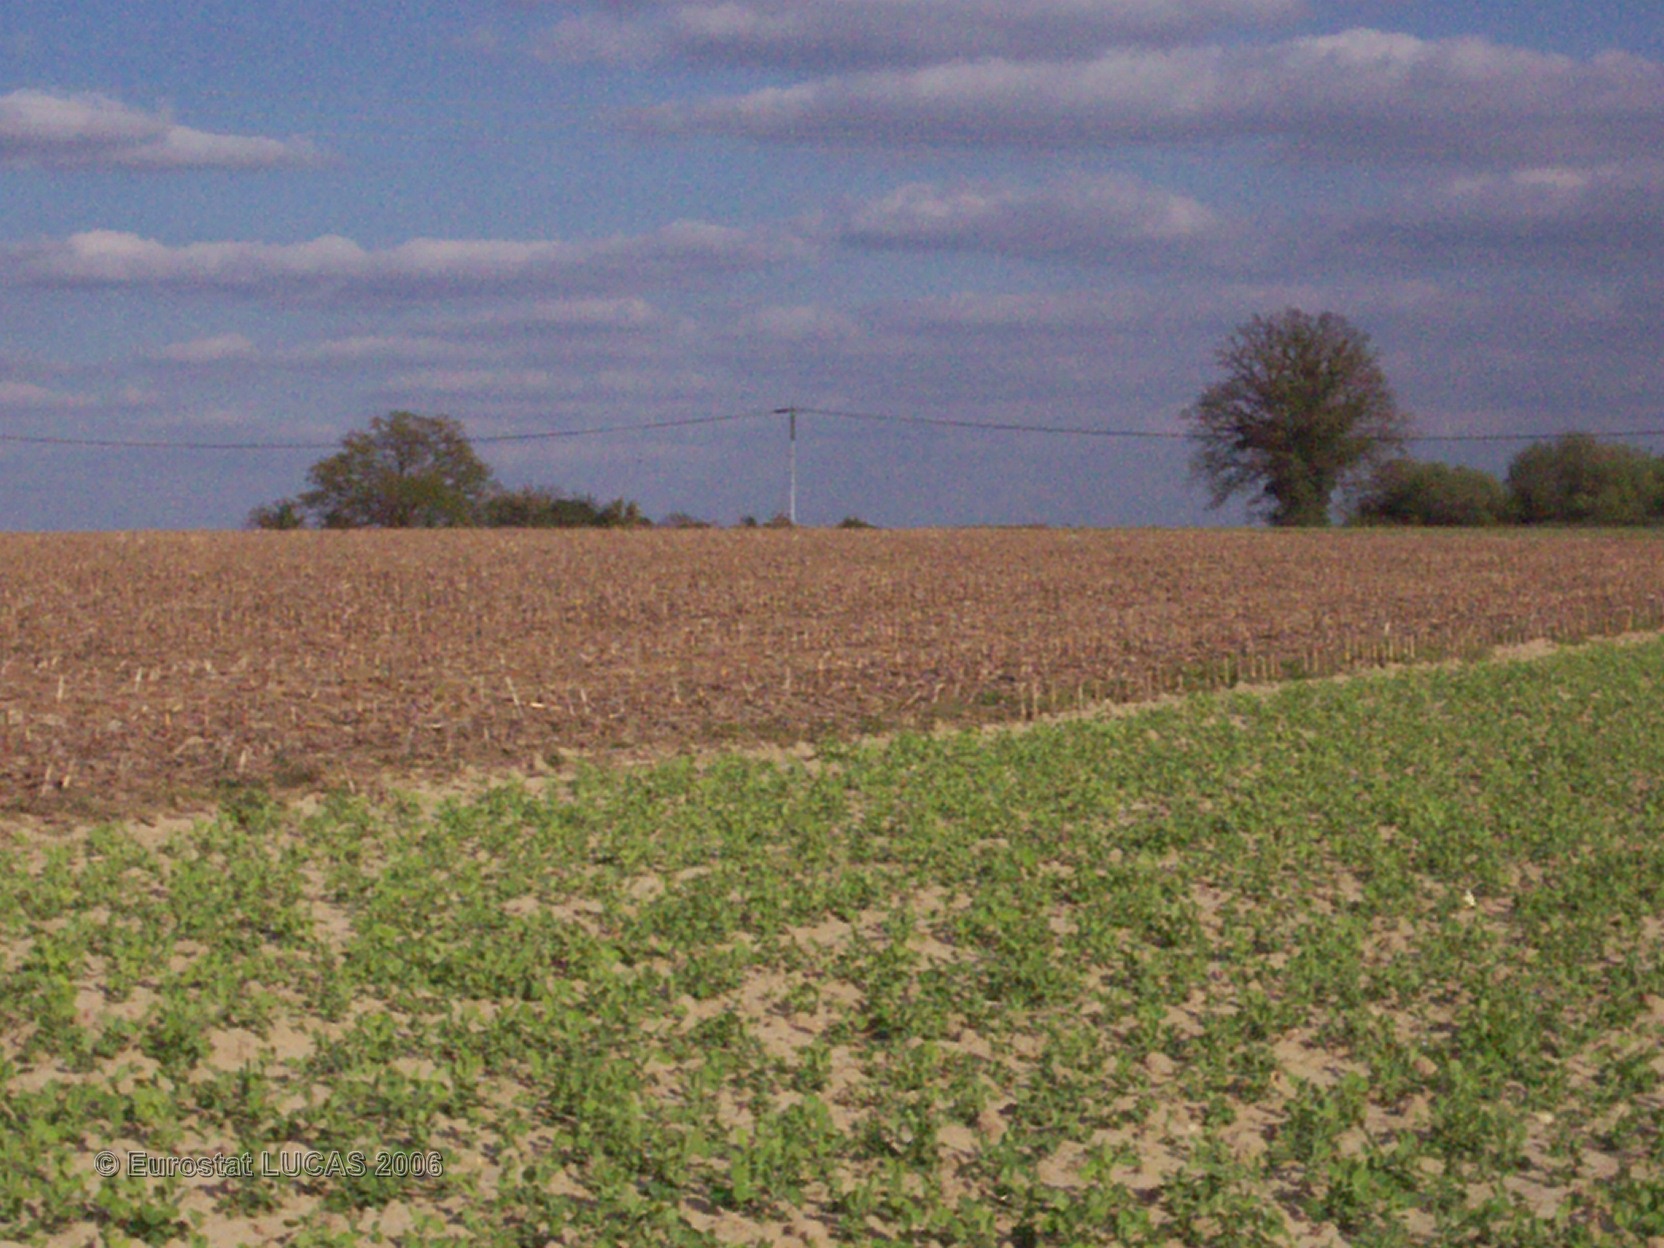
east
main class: Cropland
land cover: Dry pulses
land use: Agriculture (excluding fallow land and kitchen gardens)
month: April
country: FR
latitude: 43.4167
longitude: -0.3199
